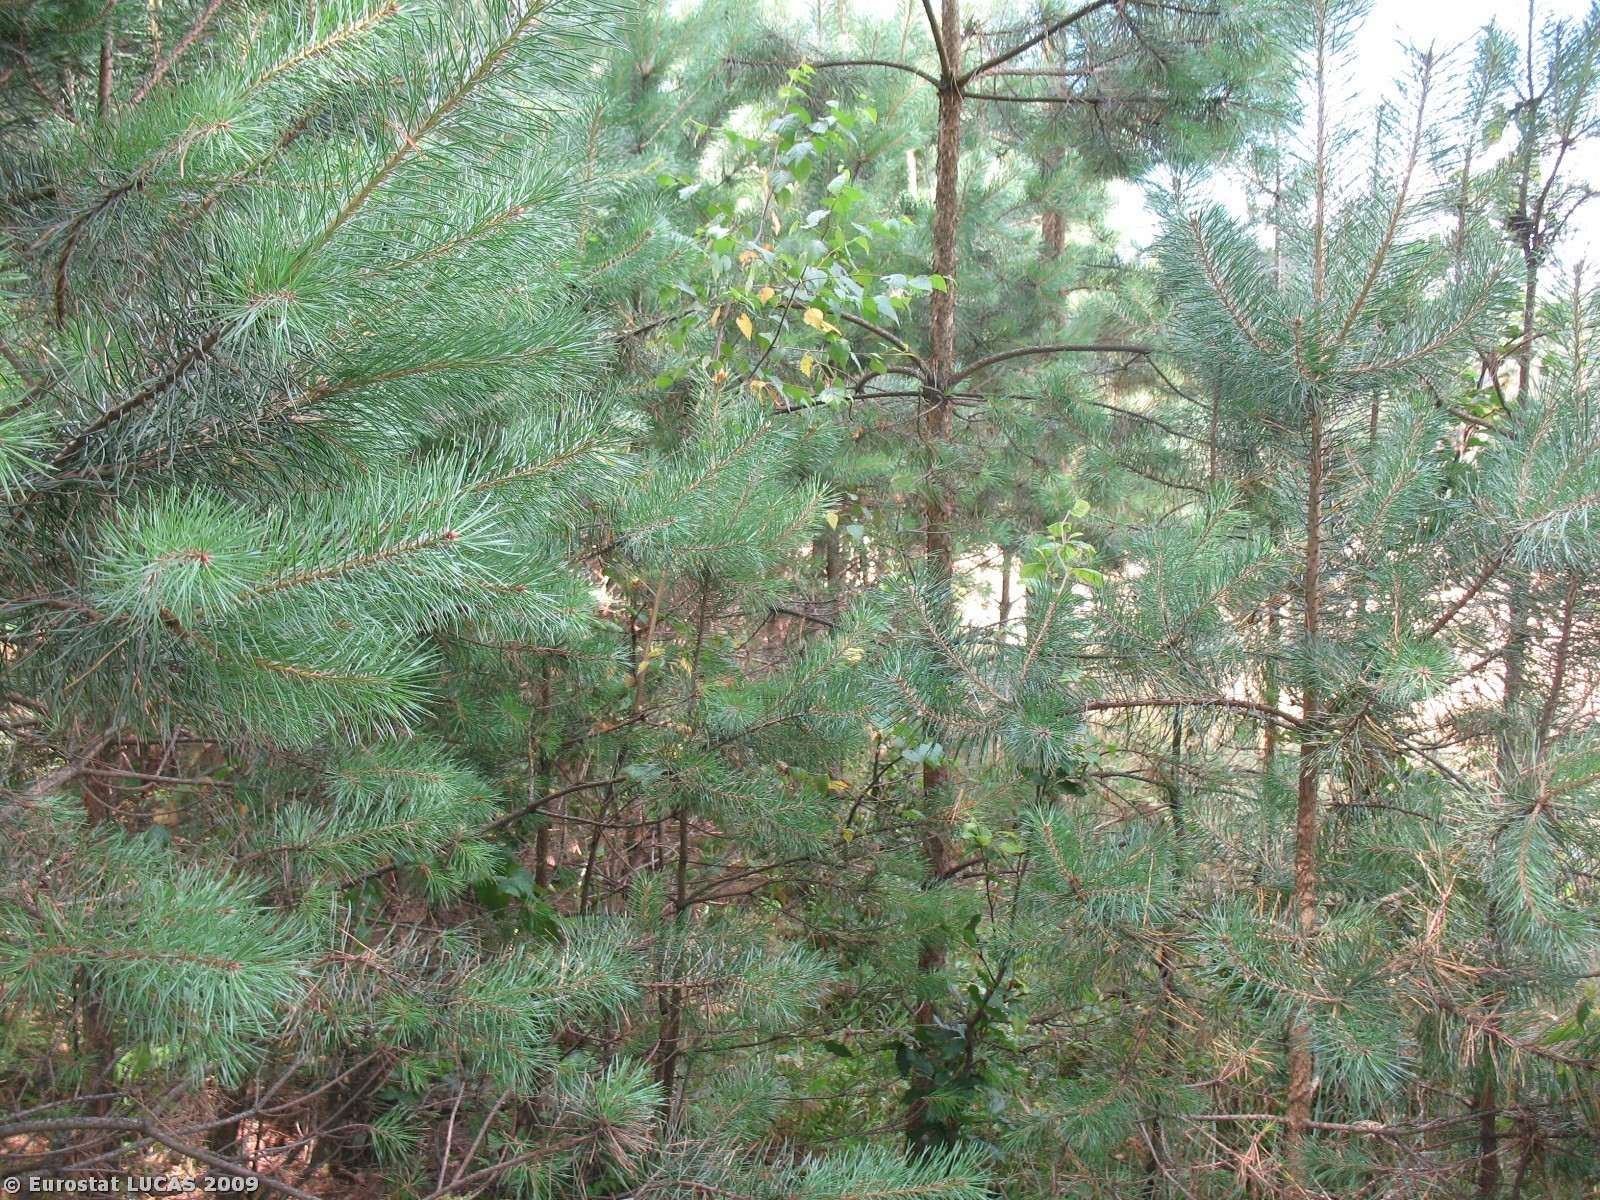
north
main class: Woodland
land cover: Coniferous woodland
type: hemiboreal forest and nemoral coniferous forest and mixed broadleaved-coniferous forest
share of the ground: > 75 %
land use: Forestry
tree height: > 5 m
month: July
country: PL
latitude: 50.2634
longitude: 22.1096
